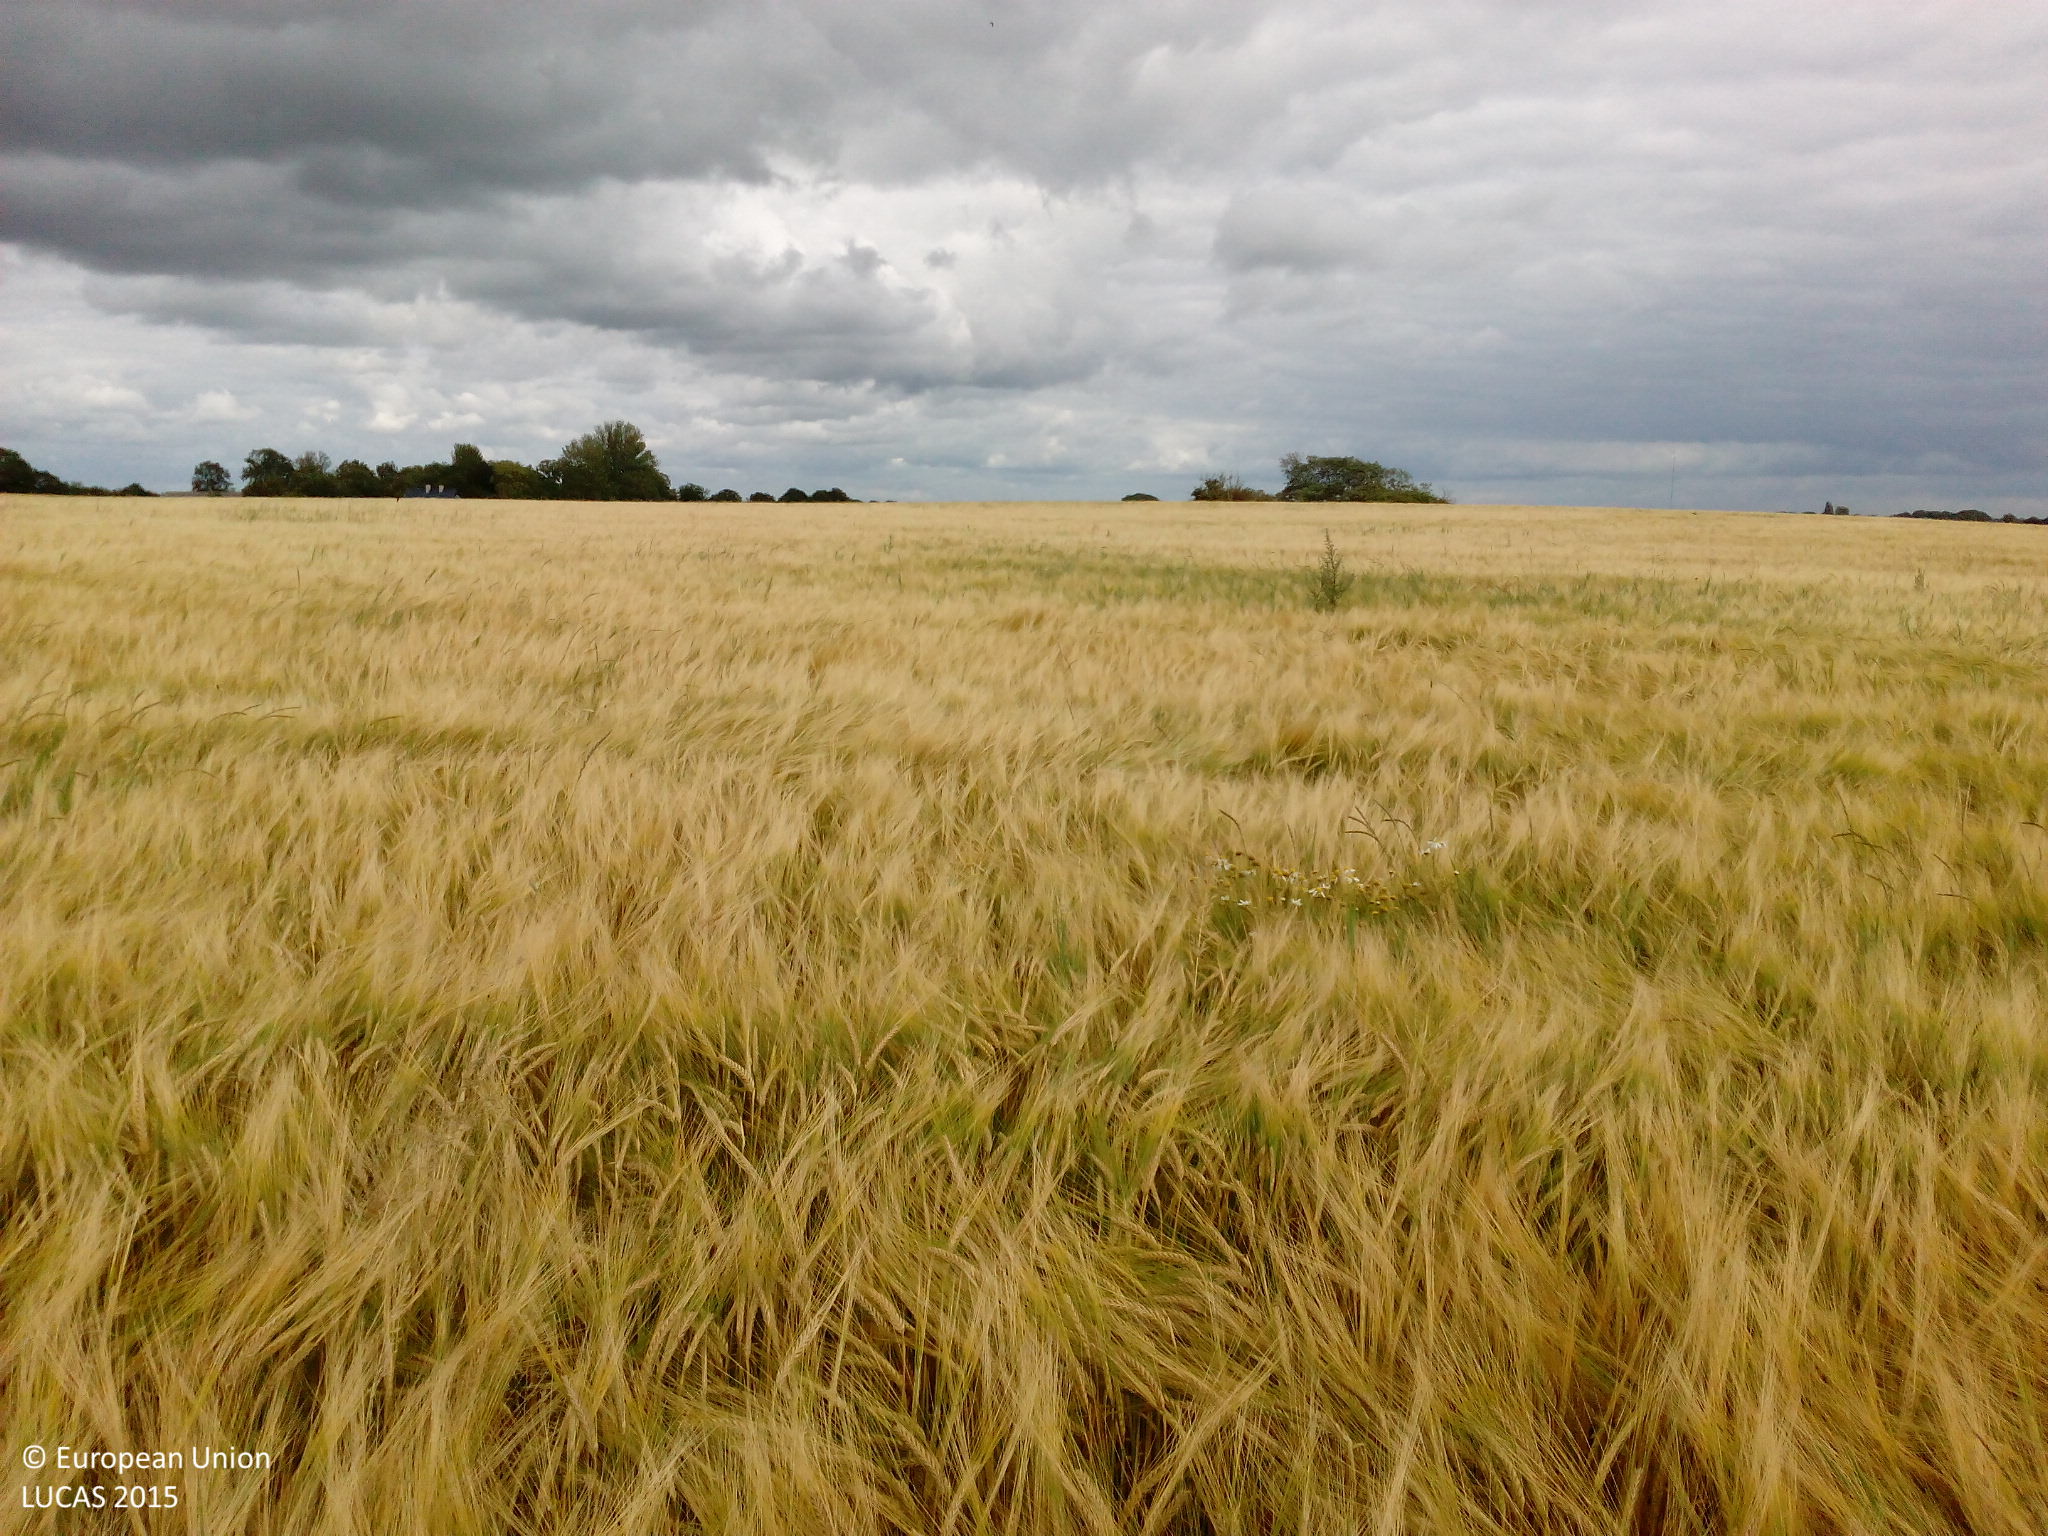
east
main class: Cropland
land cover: Barley
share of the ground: > 75 %
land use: Agriculture (excluding fallow land and kitchen gardens)
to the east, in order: Barley; Grassland without tree/shrub cover; Fences; Grassland without tree/shrub cover
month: July
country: DK
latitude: 55.7388
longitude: 12.1165
